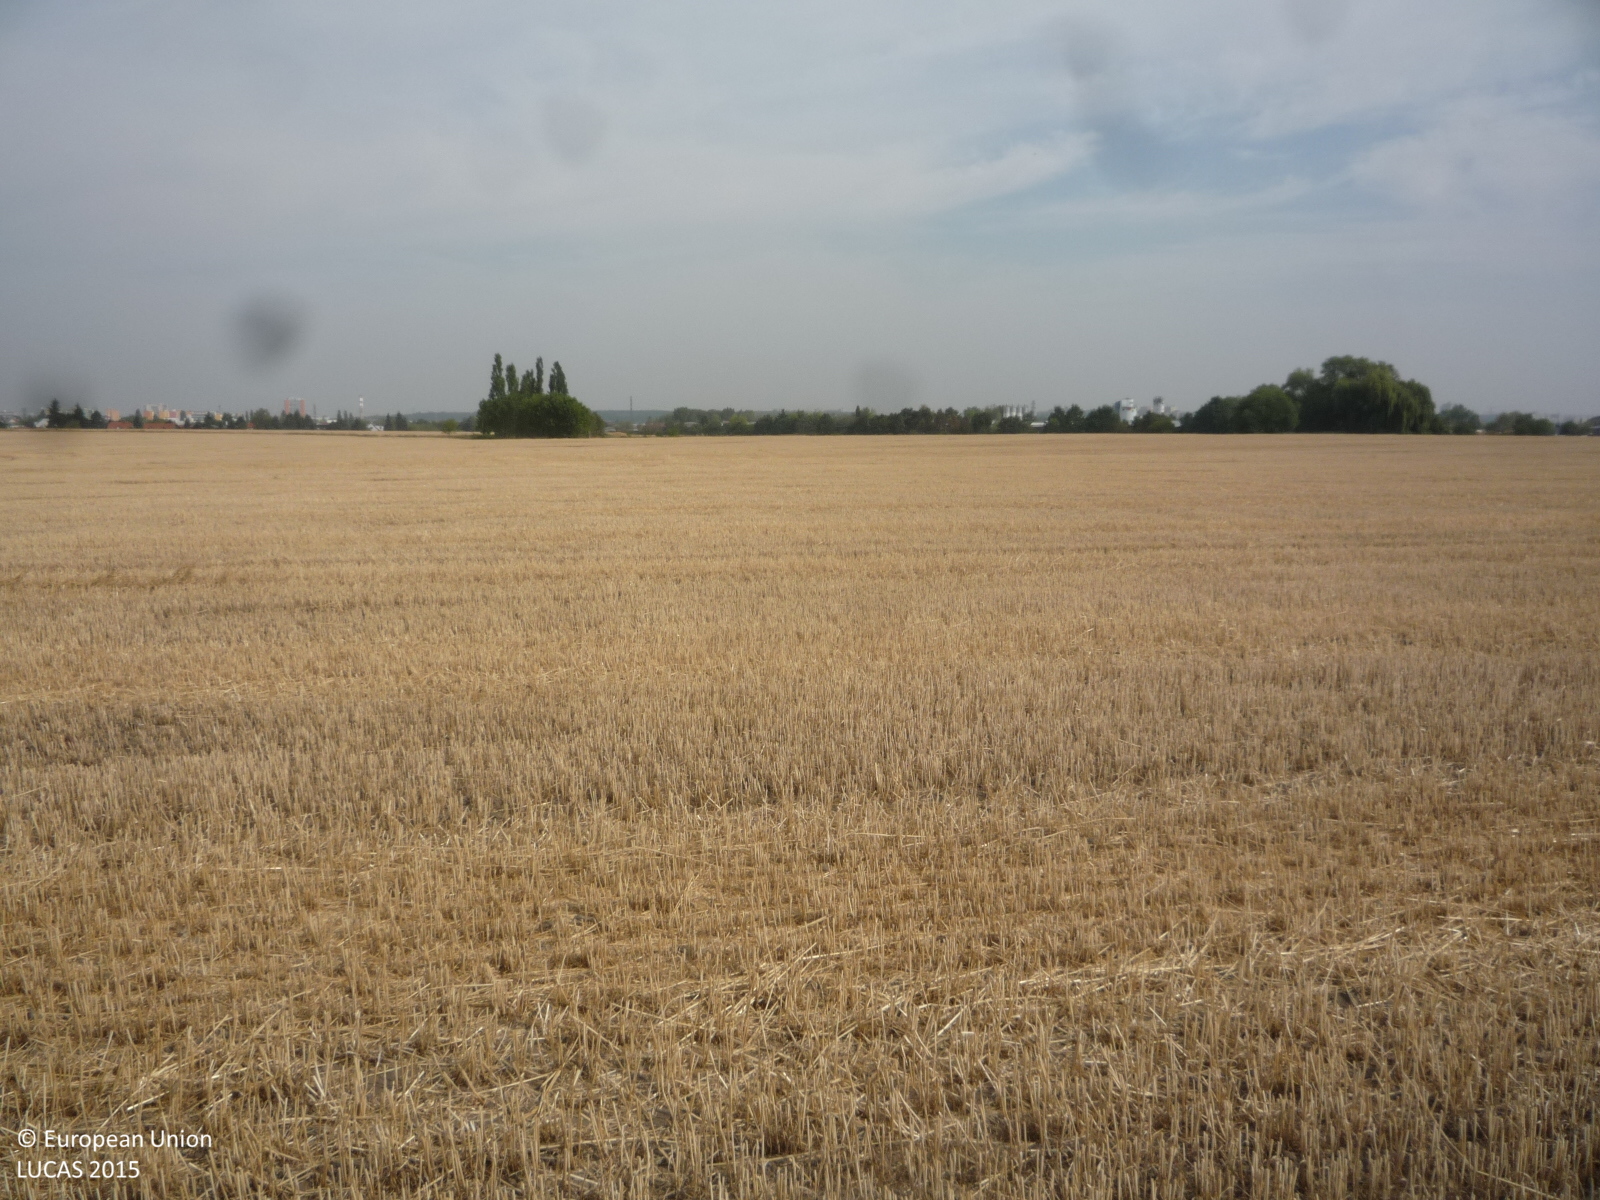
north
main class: Cropland
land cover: Common wheat
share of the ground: 25 - 50 %
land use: Agriculture (excluding fallow land and kitchen gardens)
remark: Harvested field
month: August
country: CZ
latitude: 49.9882
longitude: 14.4788
